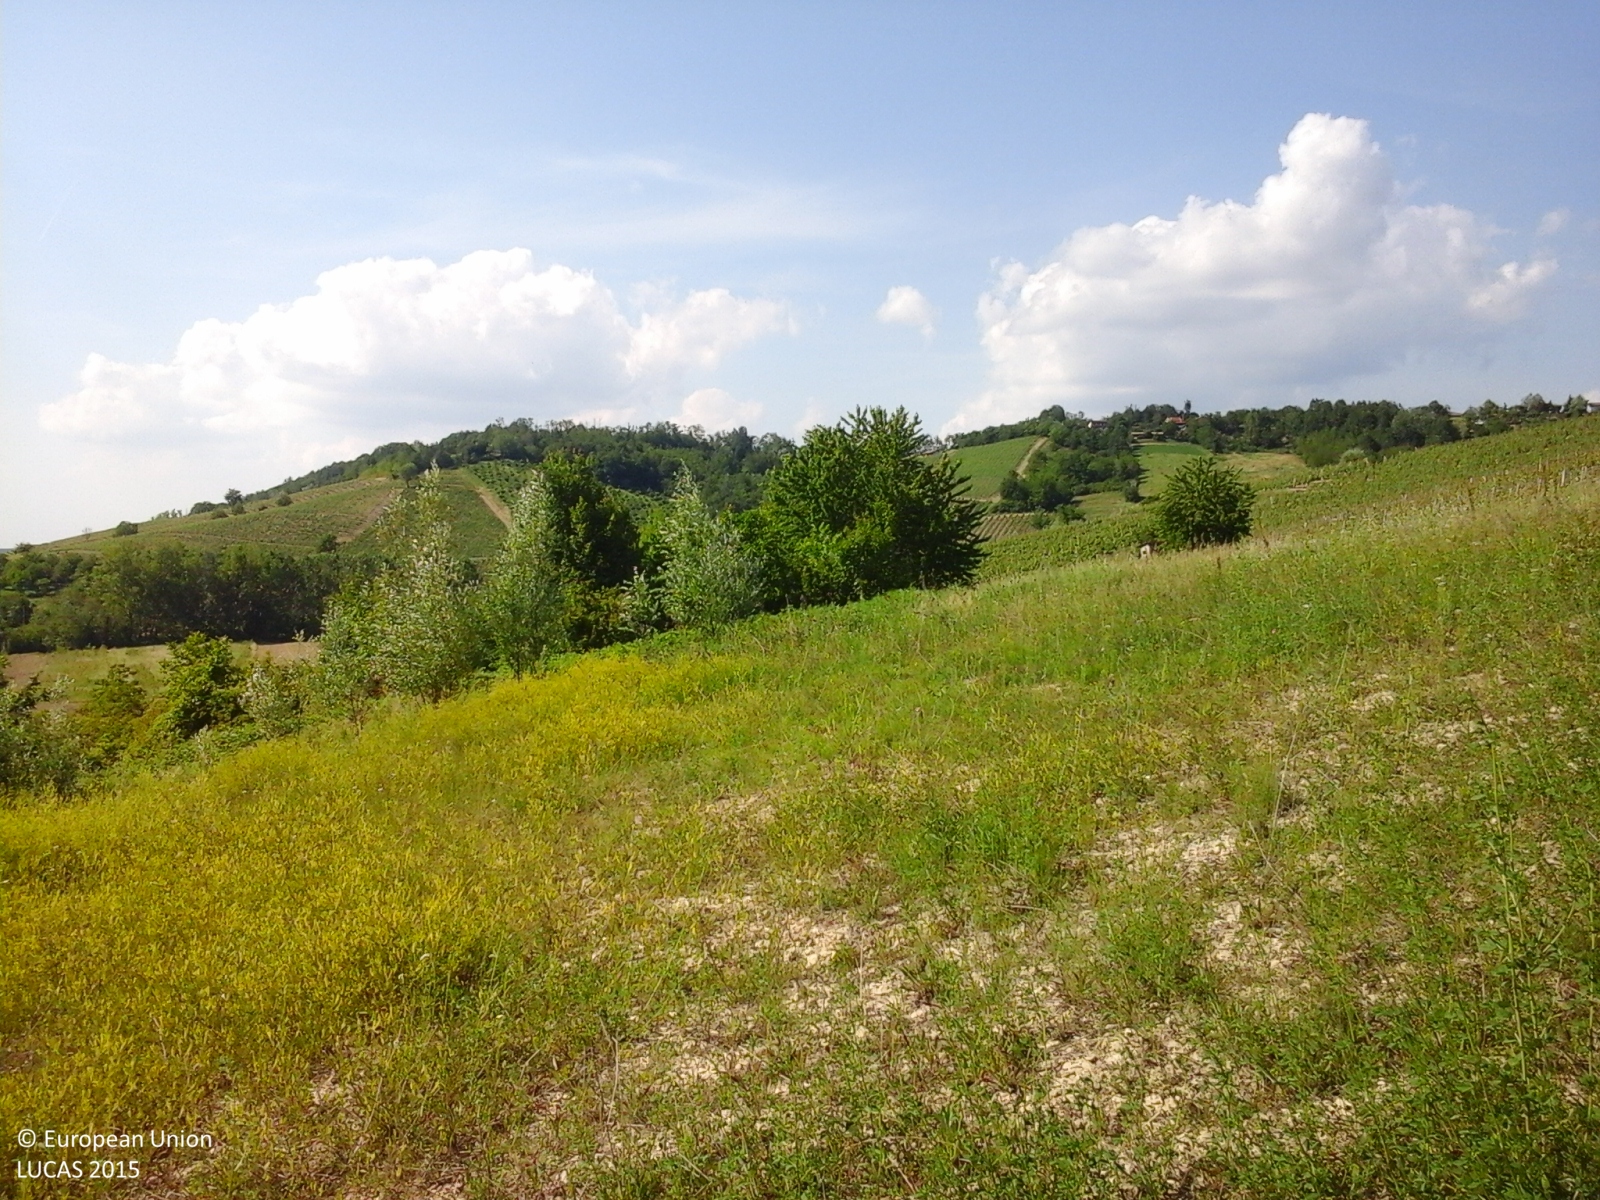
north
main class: Grassland
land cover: Spontaneously vegetated surfaces
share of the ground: > 75 %
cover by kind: herbaceous plants 100 %
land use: Fallow land
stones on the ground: < 10 %
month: May
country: IT
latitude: 44.7015
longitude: 8.5768
